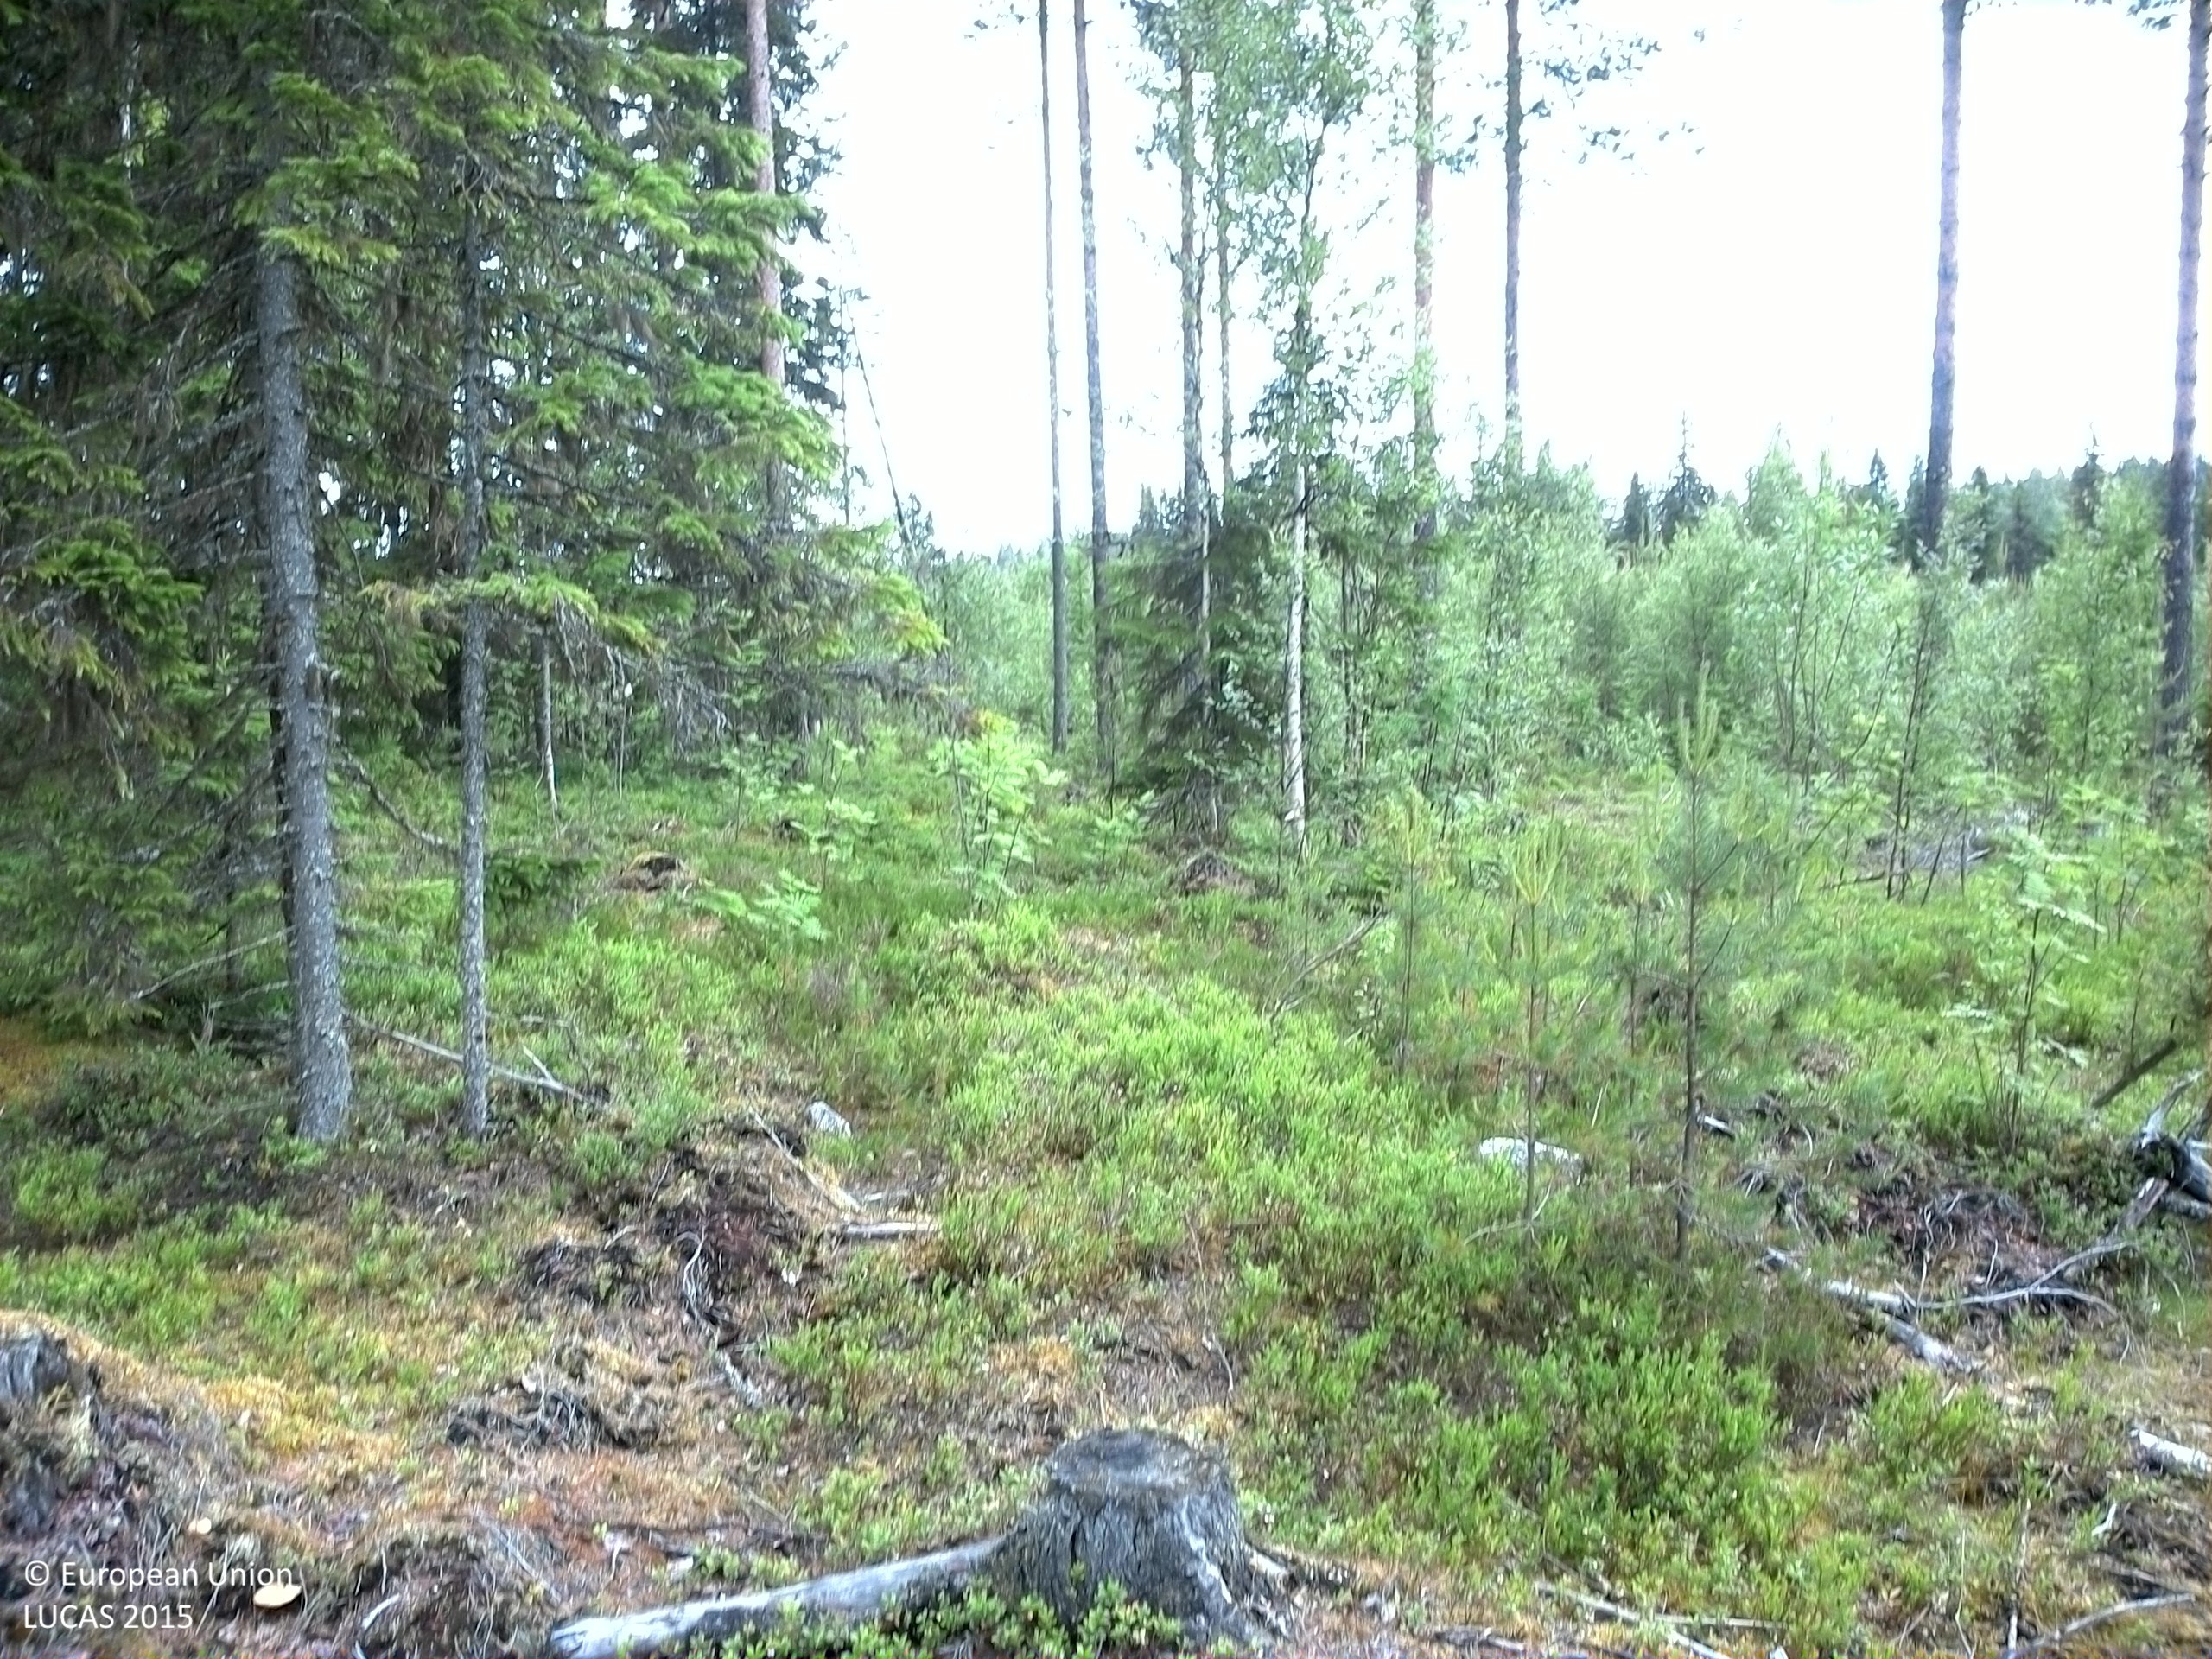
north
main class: Woodland
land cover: Pine dominated mixed woodland
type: boreal forest
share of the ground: 50 - 75 %
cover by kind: coniferous forest trees 35 %, shrubs 30 %, broadleaved forest trees 25 %, herbaceous plants 5 %, lichens and mosses 5 %
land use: Forestry
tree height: > 5 m
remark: Clear cut
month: July
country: SE
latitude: 63.5328
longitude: 18.5230
